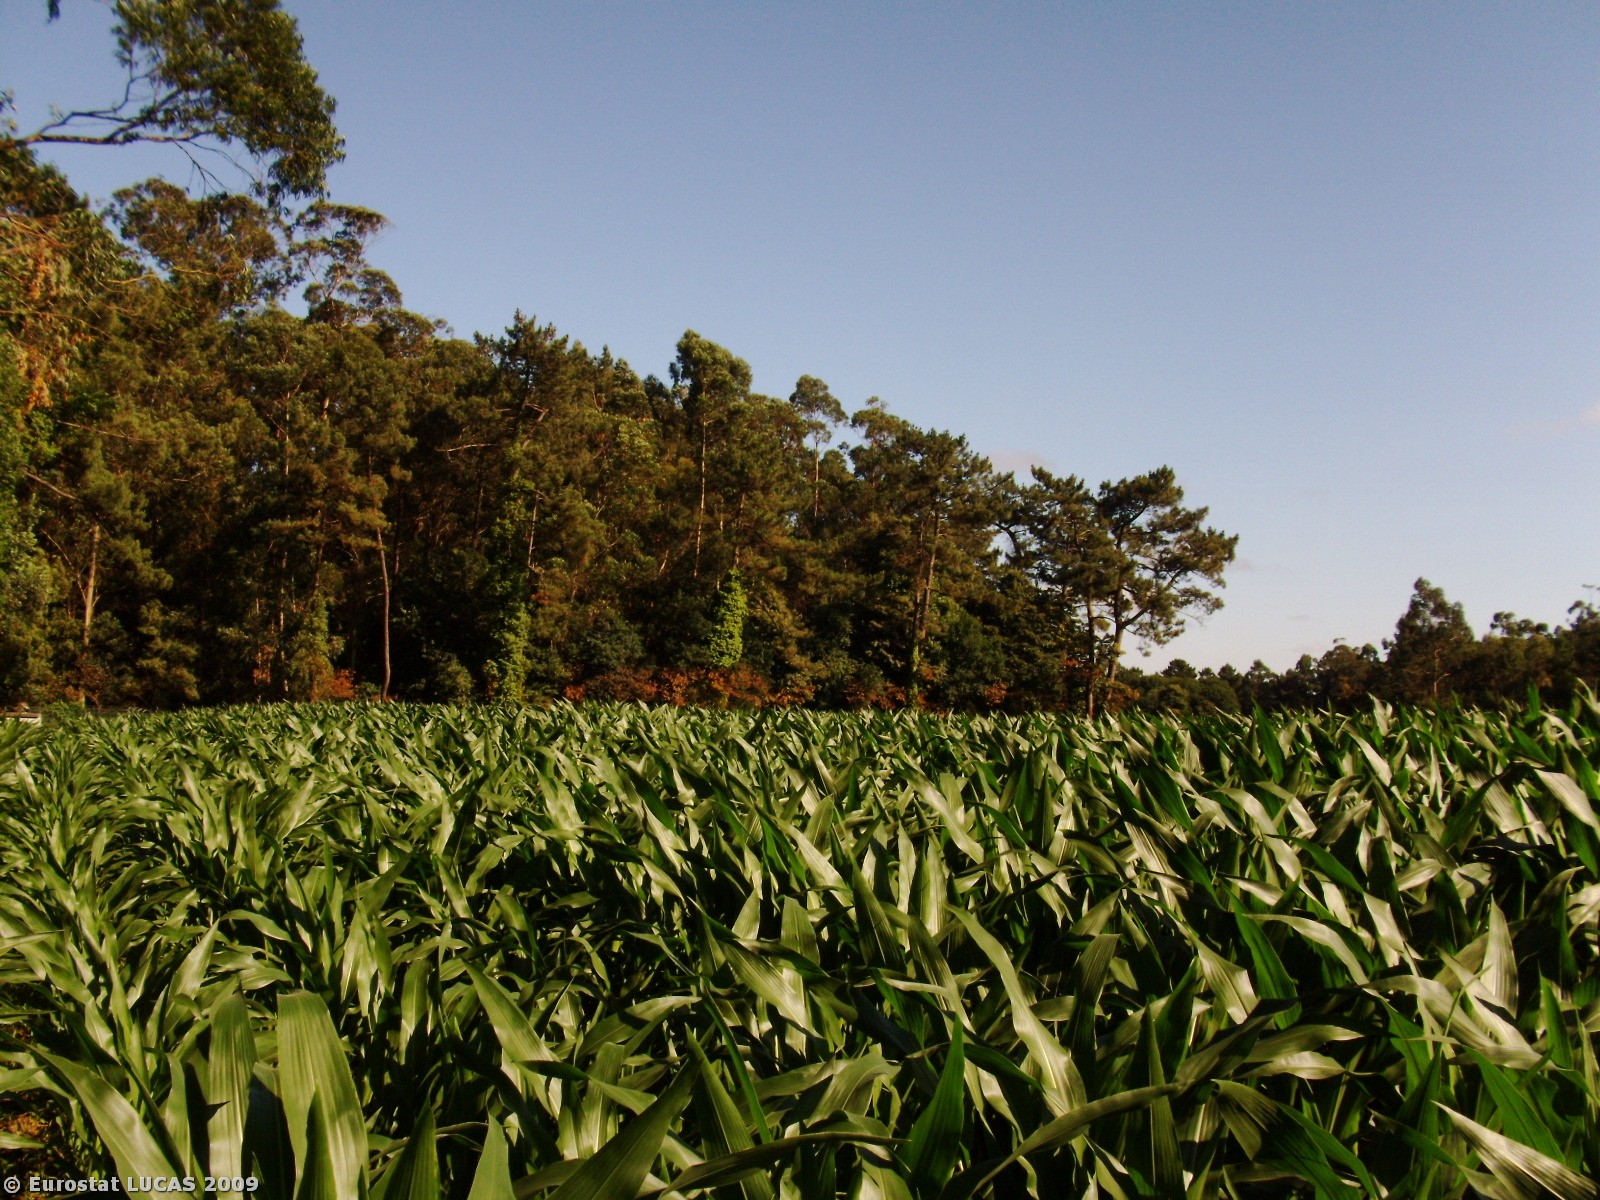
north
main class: Cropland
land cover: Maize
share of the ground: > 75 %
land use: Agriculture (excluding fallow land and kitchen gardens)
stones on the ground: < 10 %
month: June
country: PT
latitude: 41.3610
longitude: -8.6748
